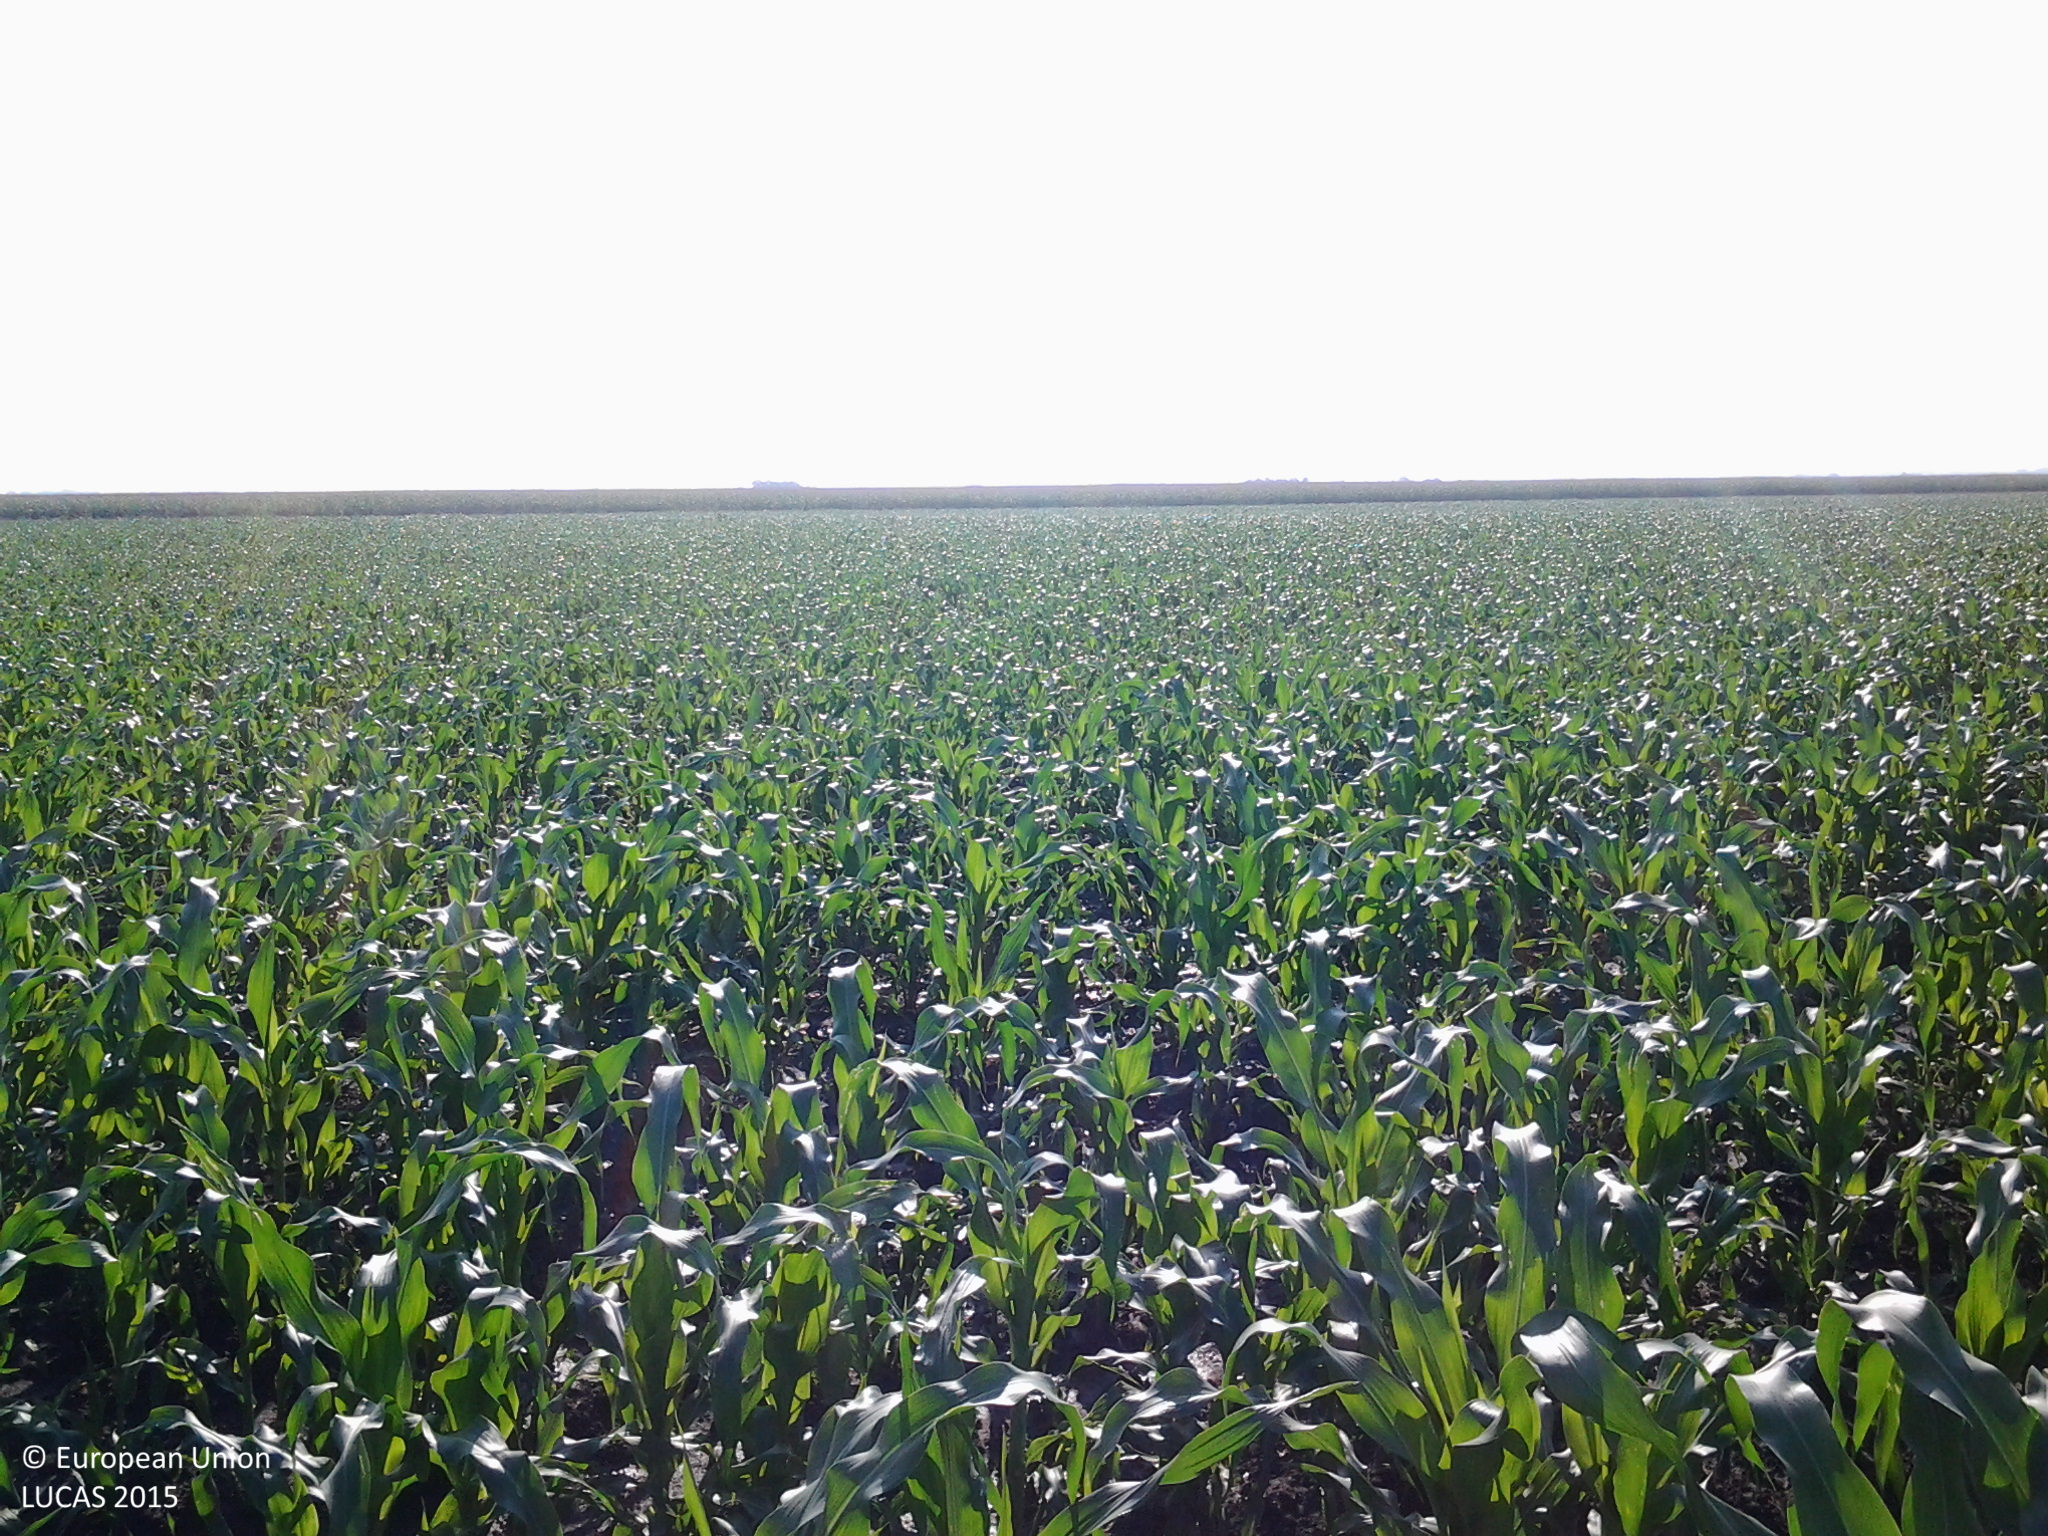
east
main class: Cropland
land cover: Maize
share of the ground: > 75 %
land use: Agriculture (excluding fallow land and kitchen gardens)
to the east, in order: Maize; Barley; Sunflower; Maize
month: July
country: HU
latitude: 46.8456
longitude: 19.1562
